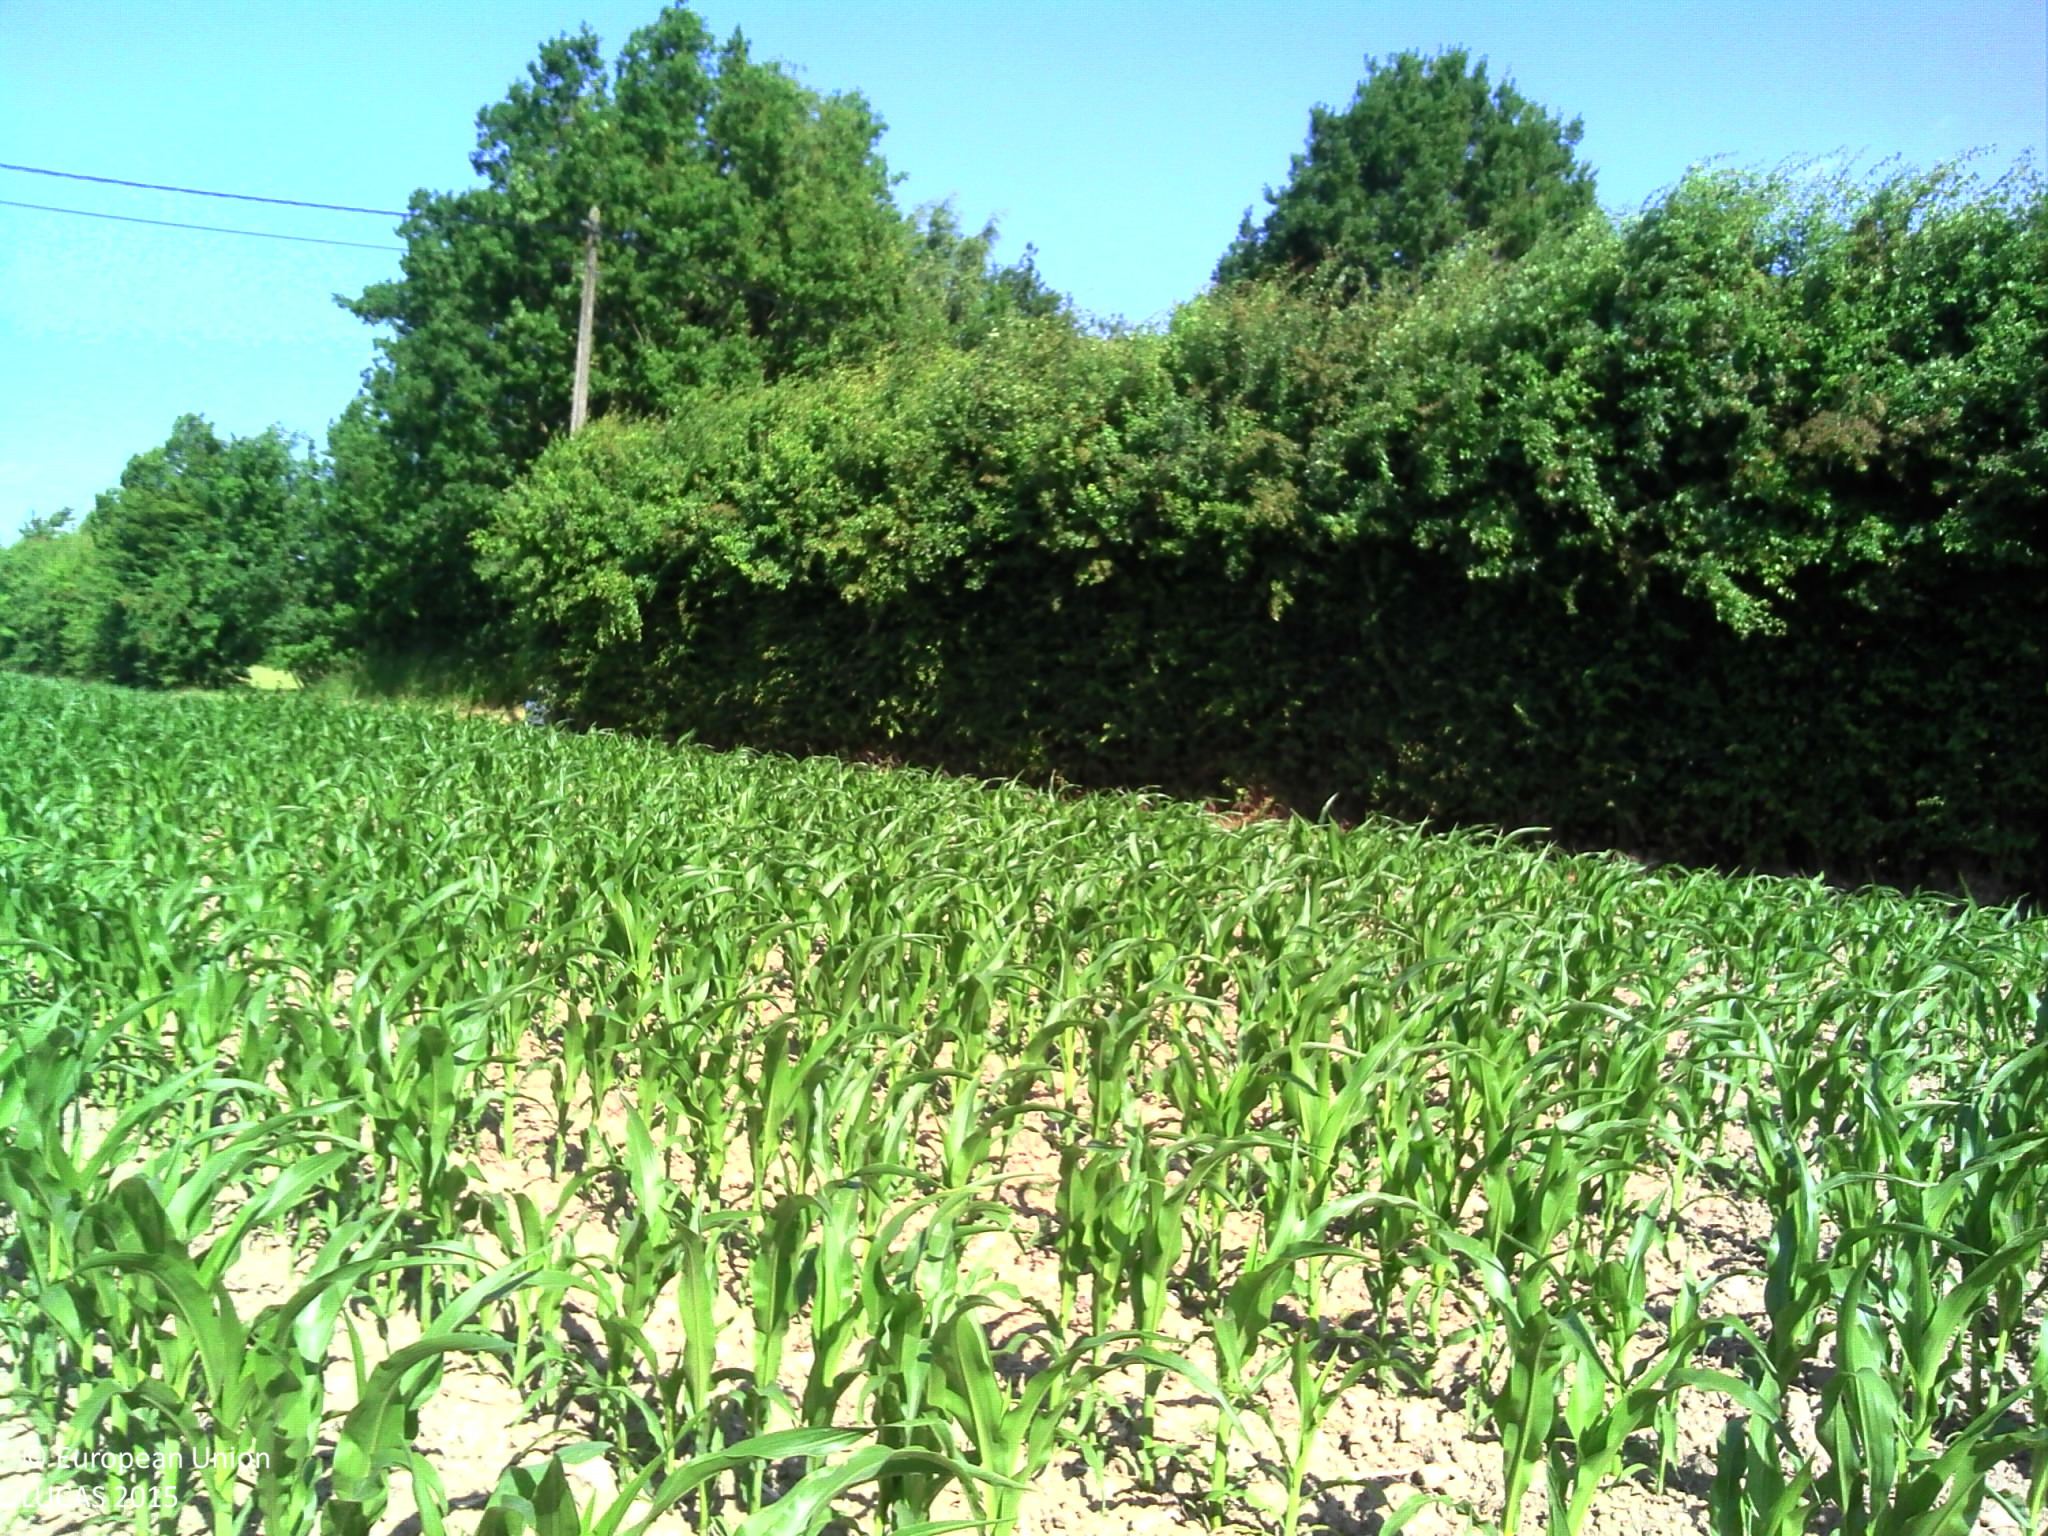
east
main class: Cropland
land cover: Maize
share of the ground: > 75 %
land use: Agriculture (excluding fallow land and kitchen gardens)
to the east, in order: Maize; Artificial constructions in urban areas; Maize
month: June
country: BE
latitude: 50.8203
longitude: 3.6762
